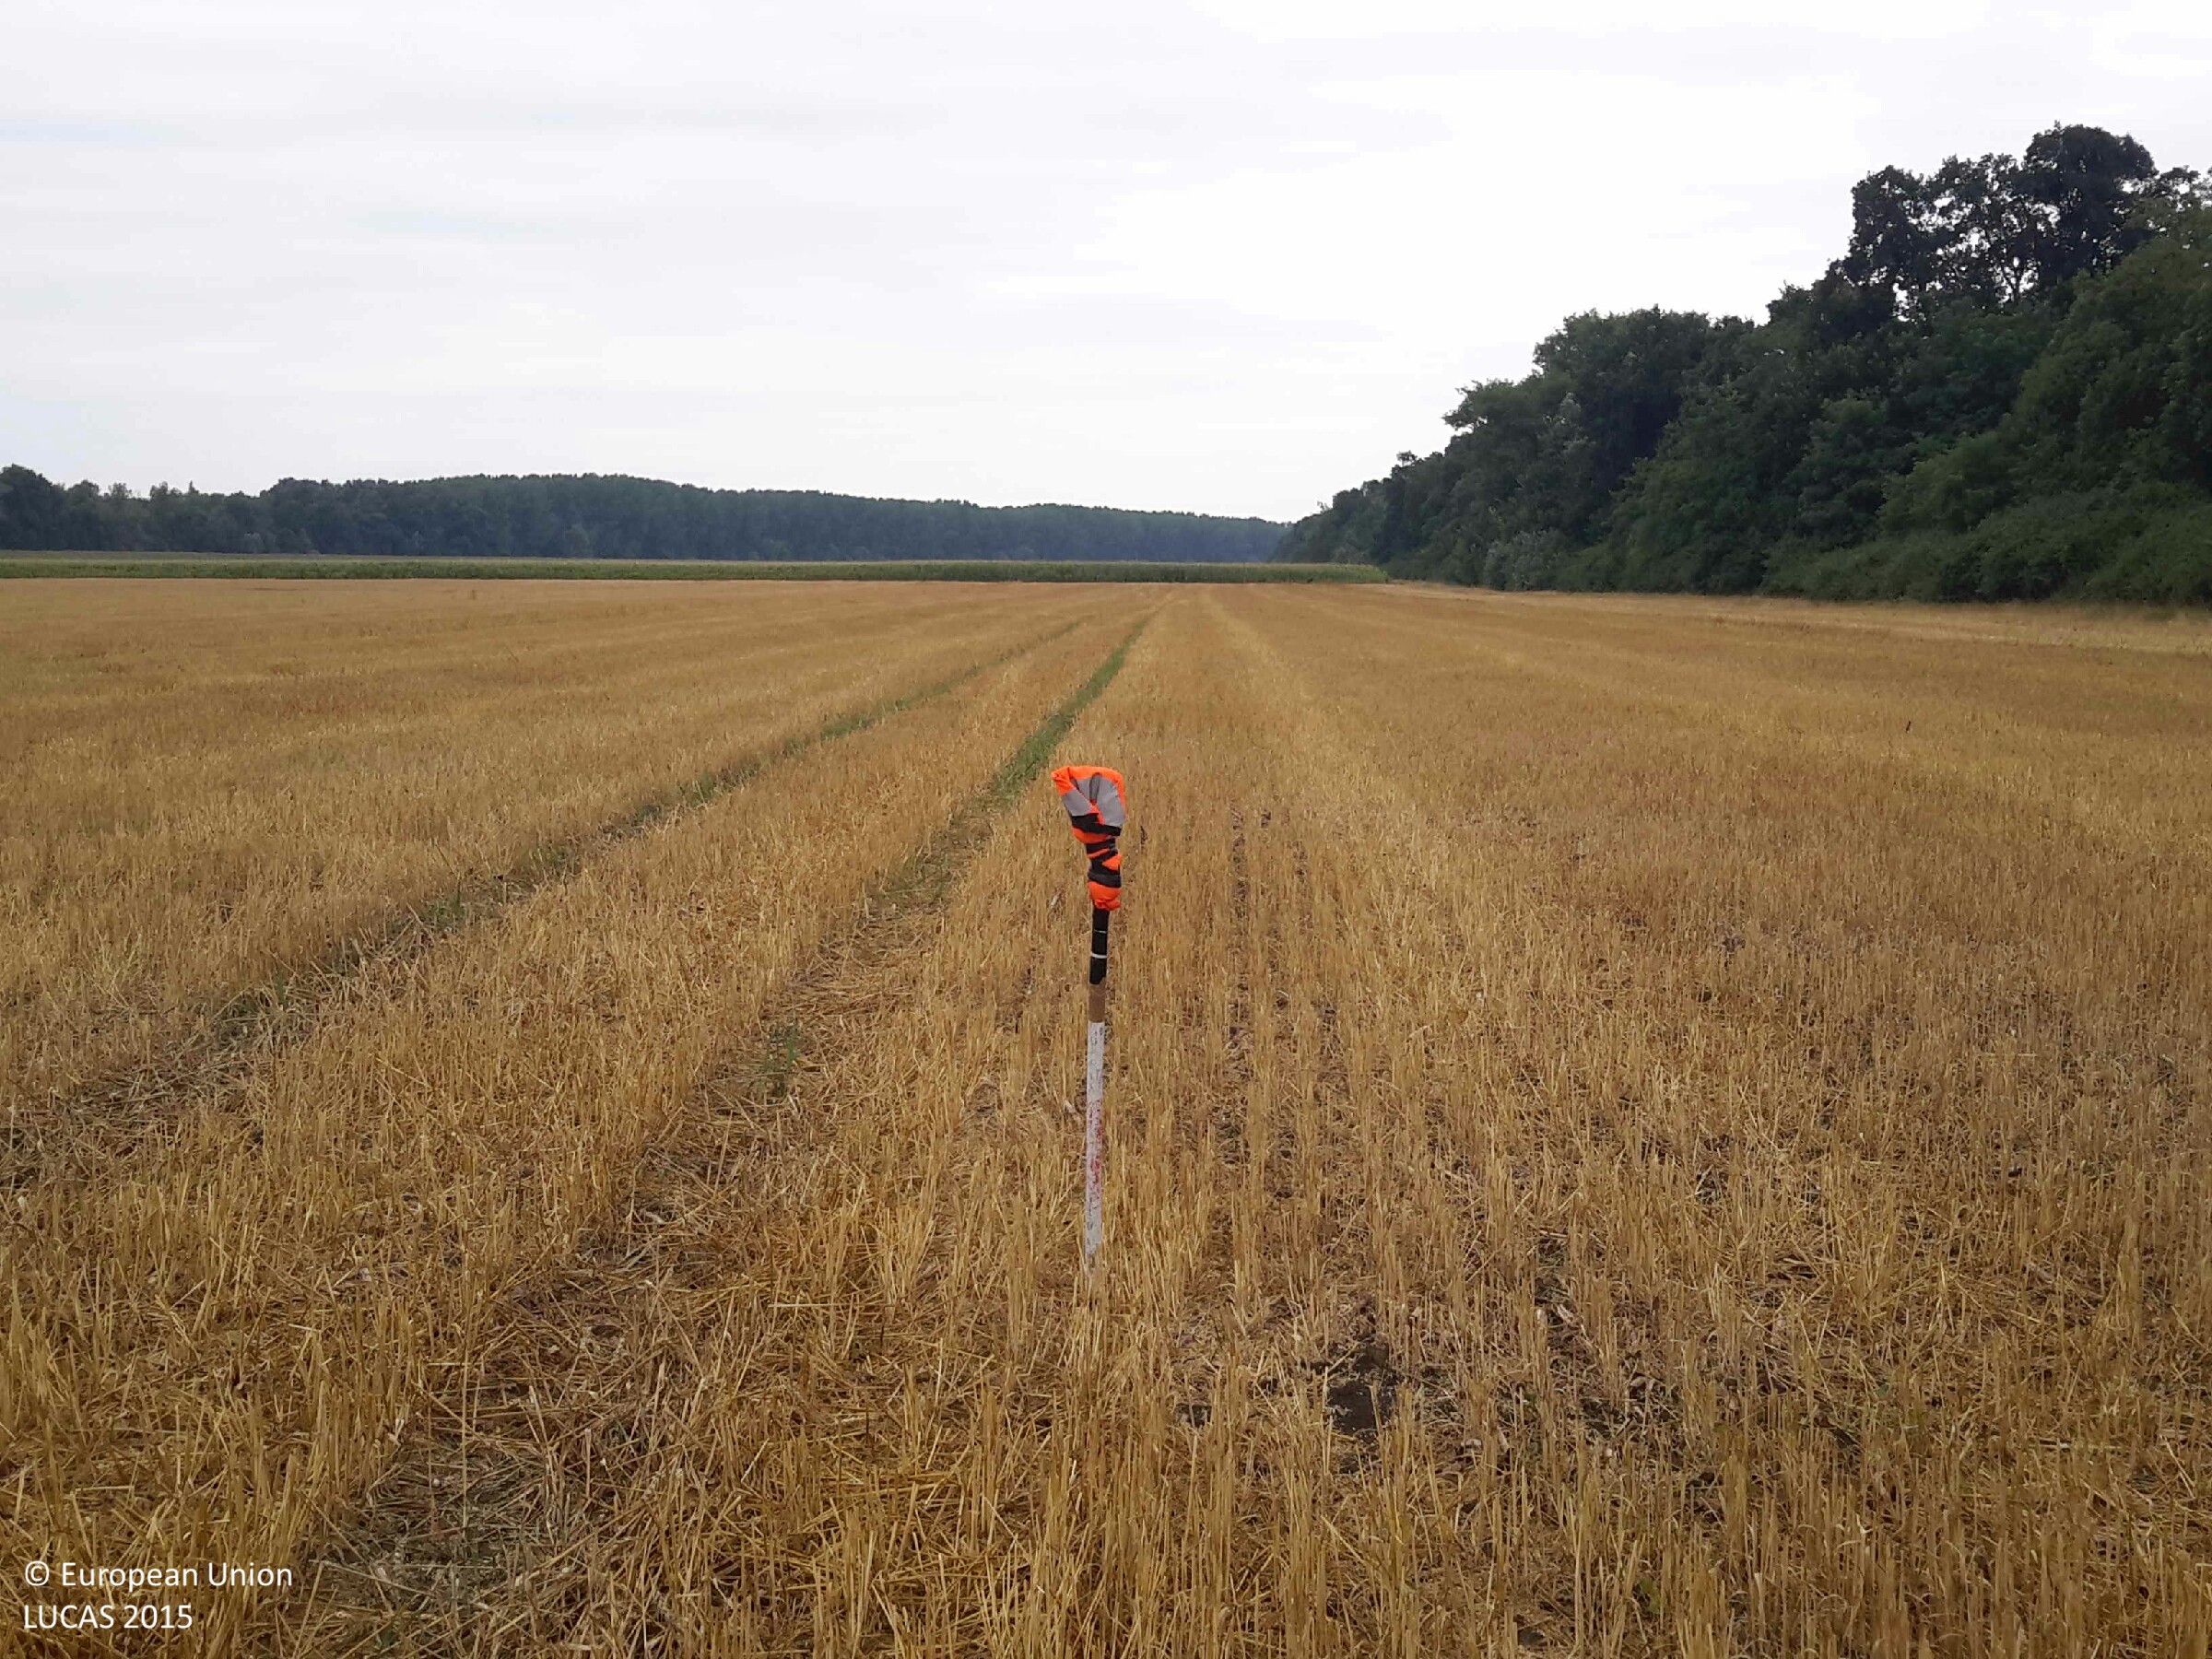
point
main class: Cropland
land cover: Common wheat
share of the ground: 50 - 75 %
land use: Agriculture (excluding fallow land and kitchen gardens)
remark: Harvested field
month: July
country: HU
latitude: 47.5226
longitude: 17.4051
